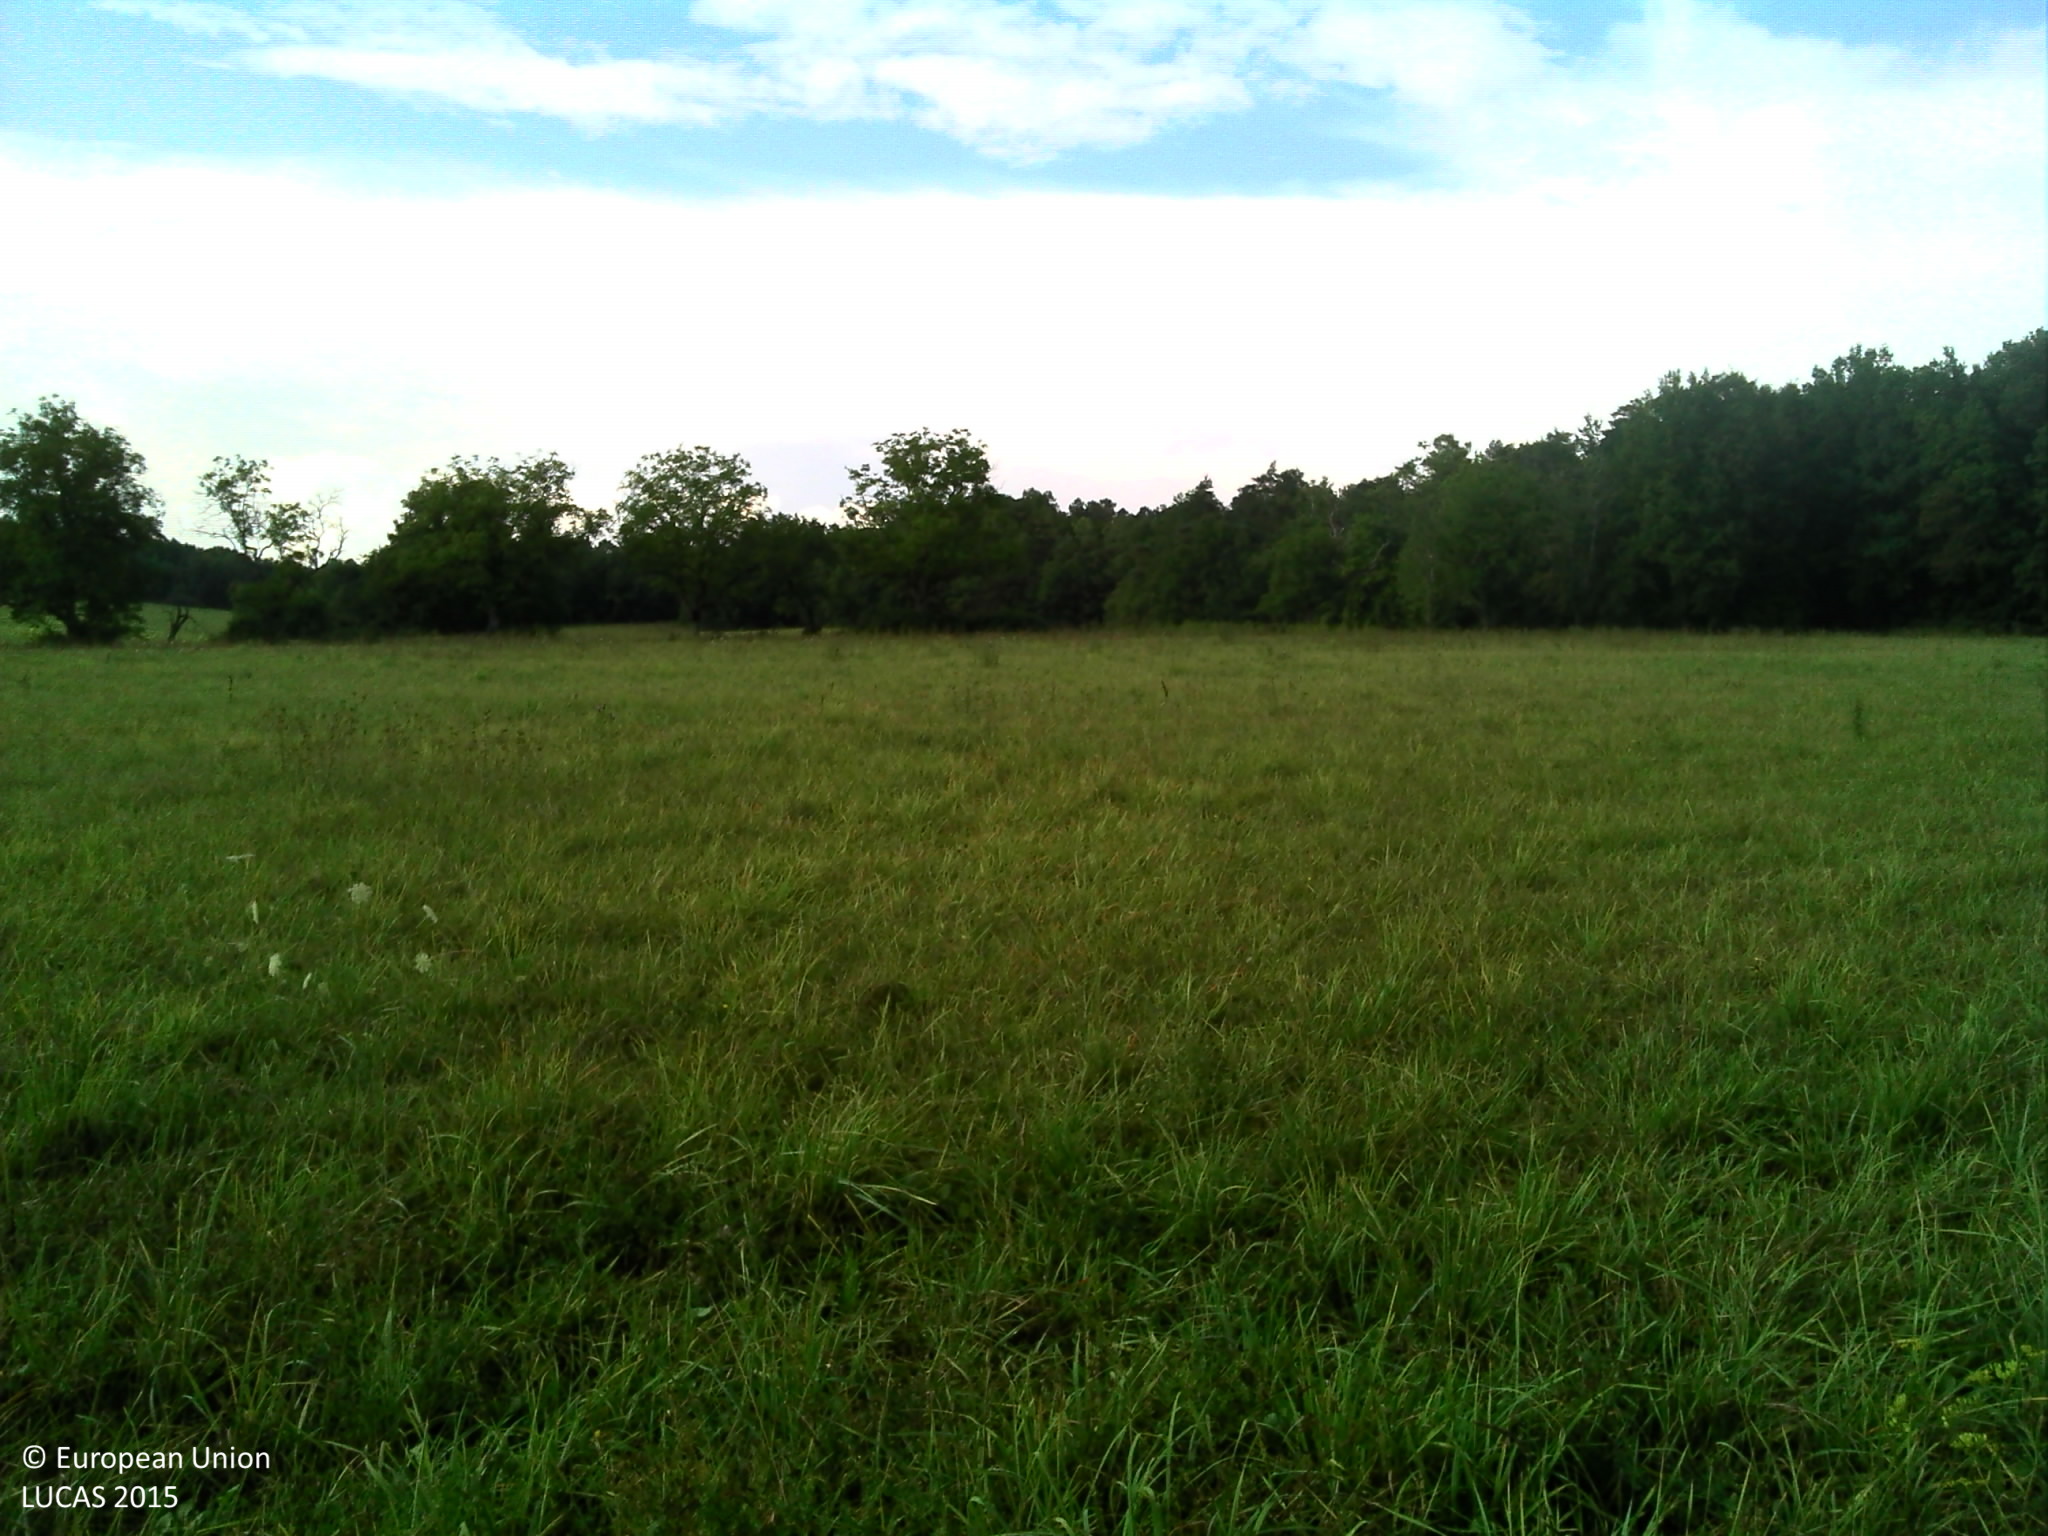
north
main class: Grassland
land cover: Grassland without tree/shrub cover
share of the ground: > 75 %
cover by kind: herbaceous plants 100 %
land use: Agriculture (excluding fallow land and kitchen gardens)
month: August
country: FR
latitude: 45.3993
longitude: 0.6759
